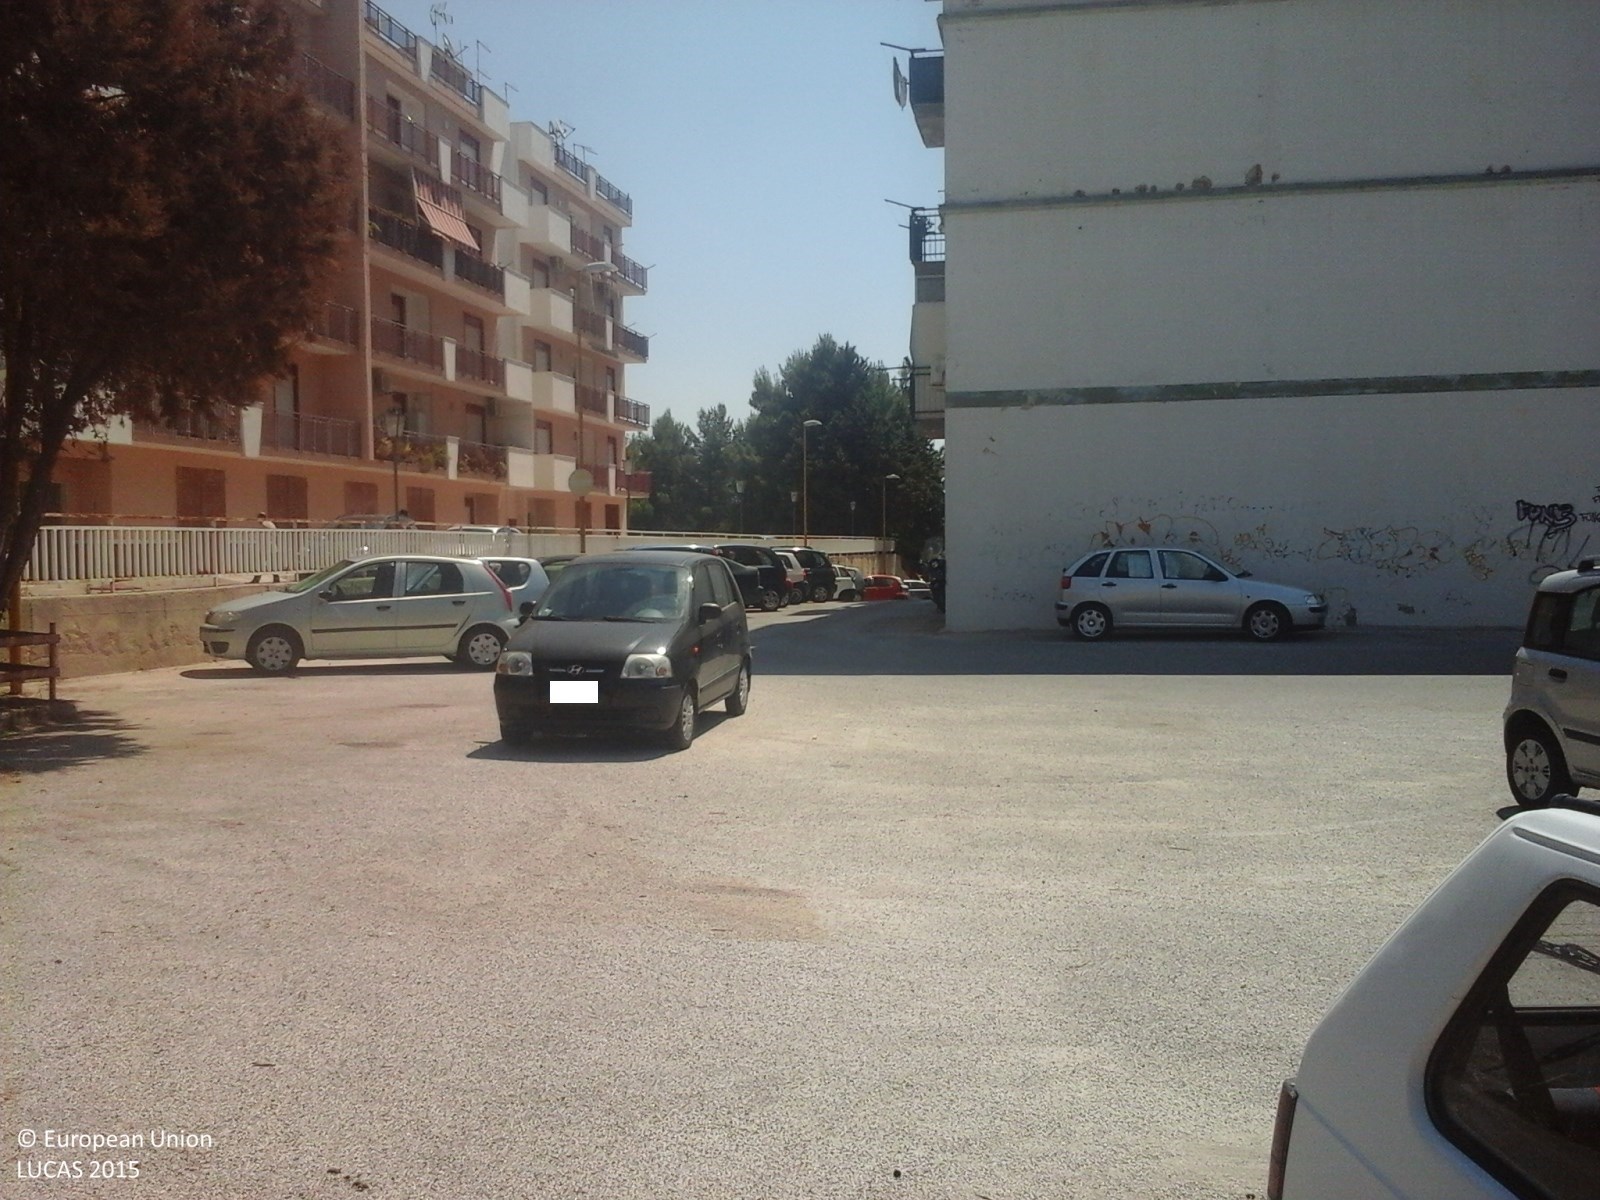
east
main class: Grassland
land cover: Grassland without tree/shrub cover
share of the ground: > 75 %
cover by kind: herbaceous plants 100 %
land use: Abandoned areas
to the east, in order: Grassland without tree/shrub cover; Other mixed woodland; Artificial constructions in urban areas
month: July
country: IT
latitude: 37.2997
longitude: 13.5485
